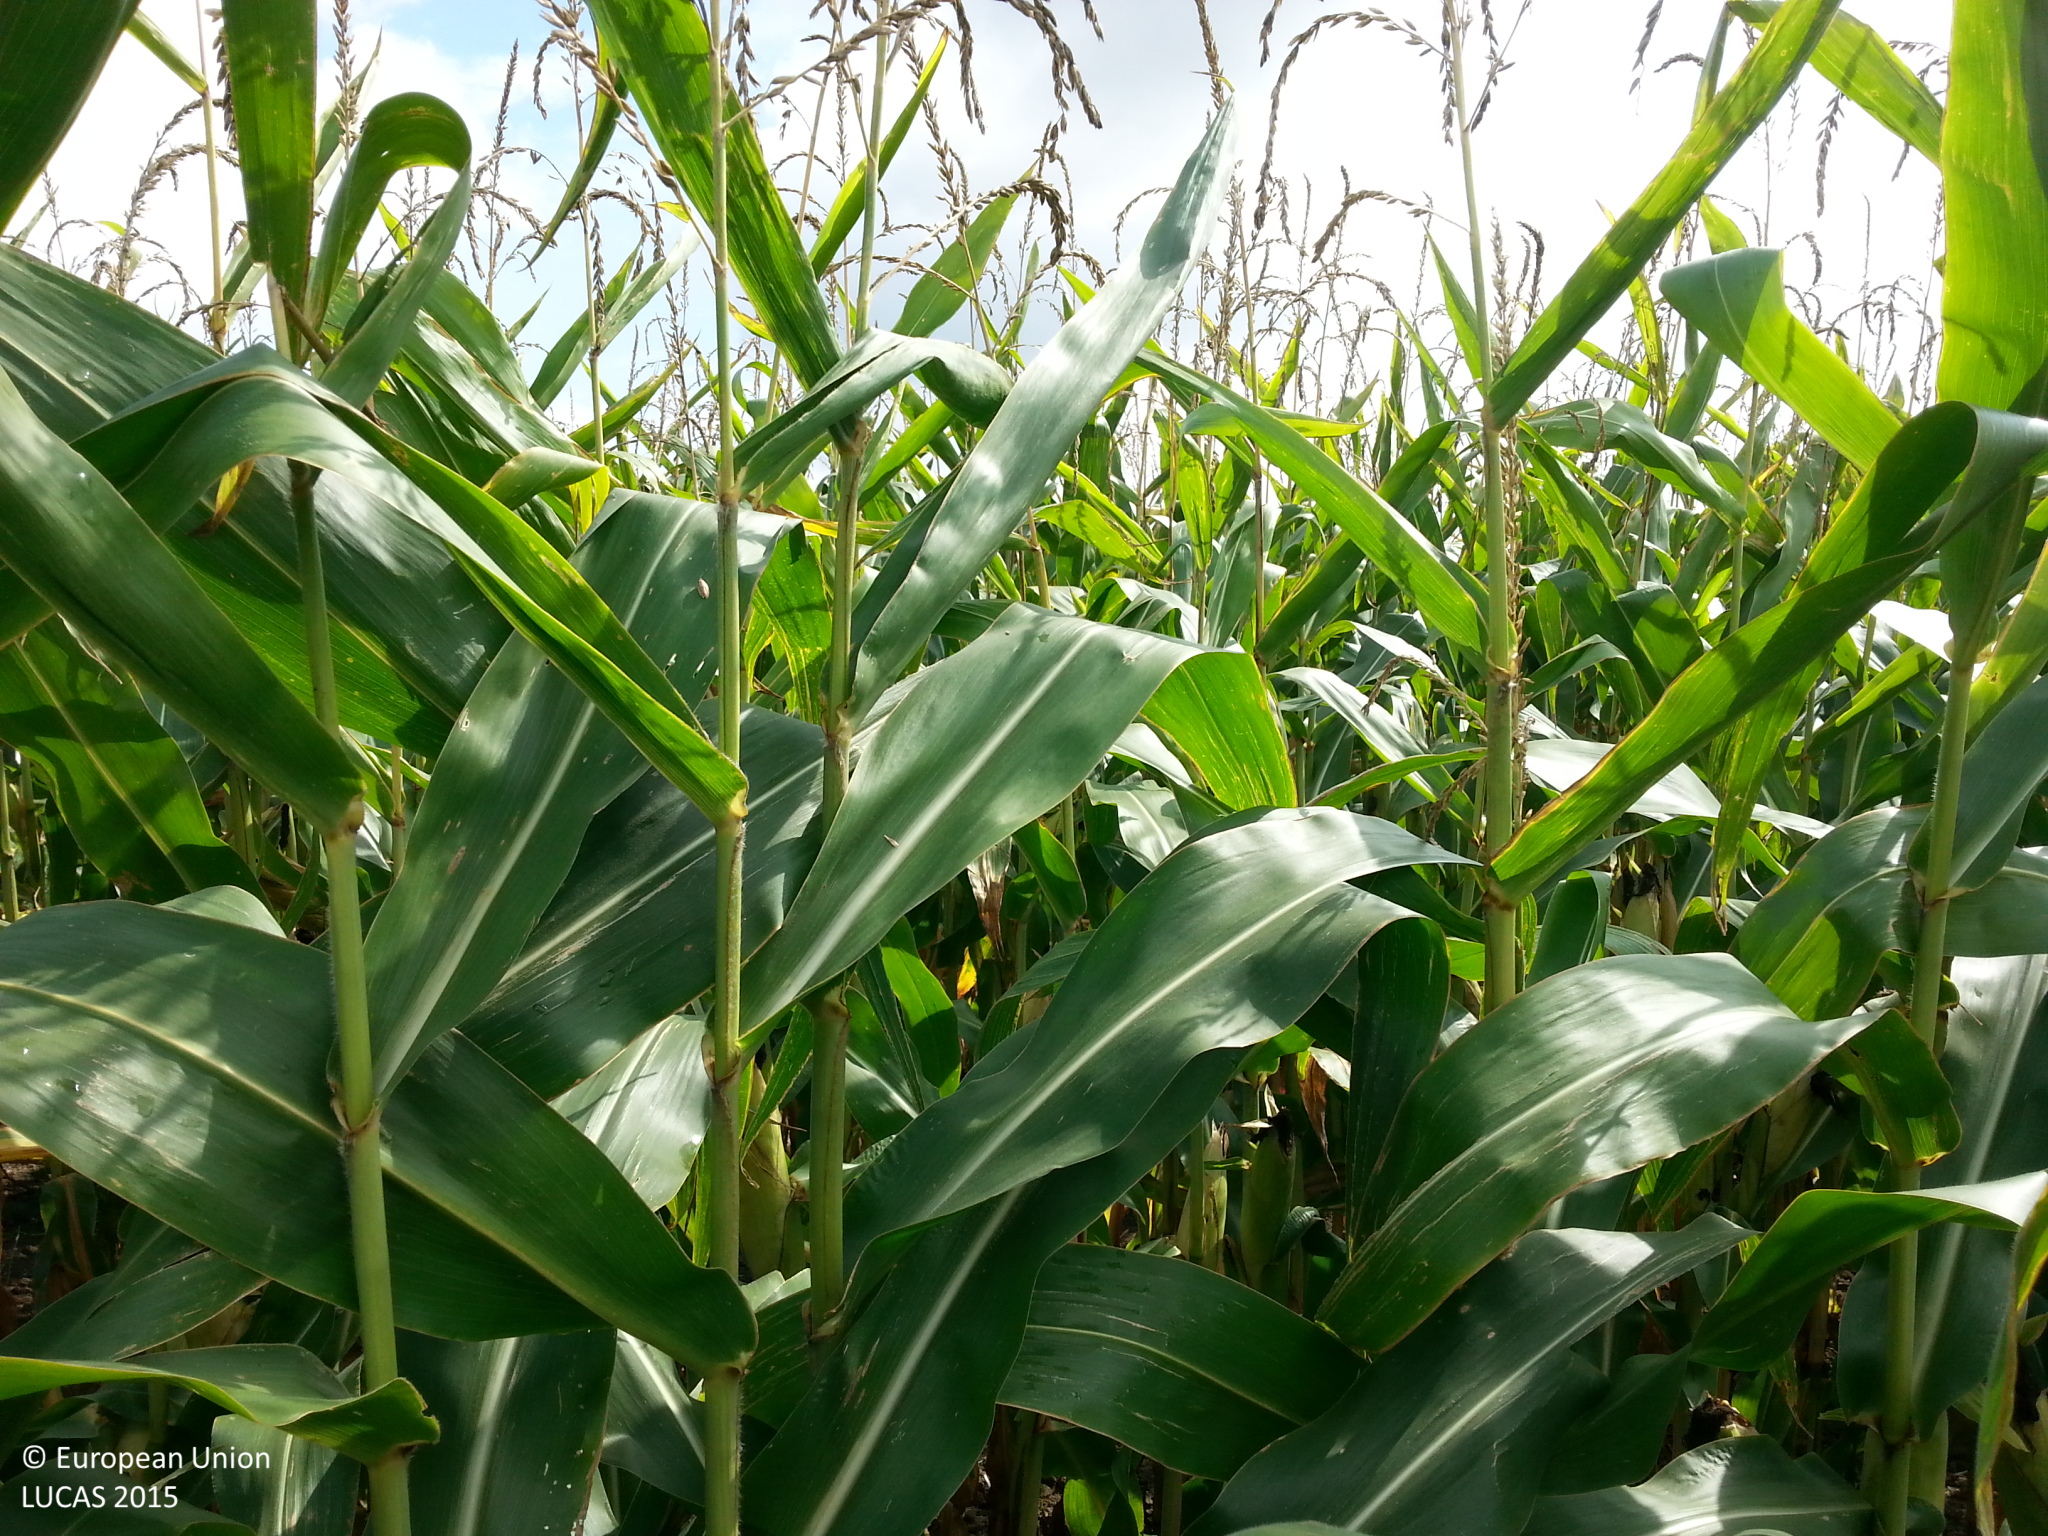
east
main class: Cropland
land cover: Maize
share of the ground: > 75 %
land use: Agriculture (excluding fallow land and kitchen gardens)
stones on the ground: < 10 %
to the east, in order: Maize; Grass margins; Common wheat; Grass margins; Ditches and canals; Grass margins; Paved roads, cycling and walking lanes; Grass margins
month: September
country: DE
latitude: 49.3389
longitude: 9.9312
